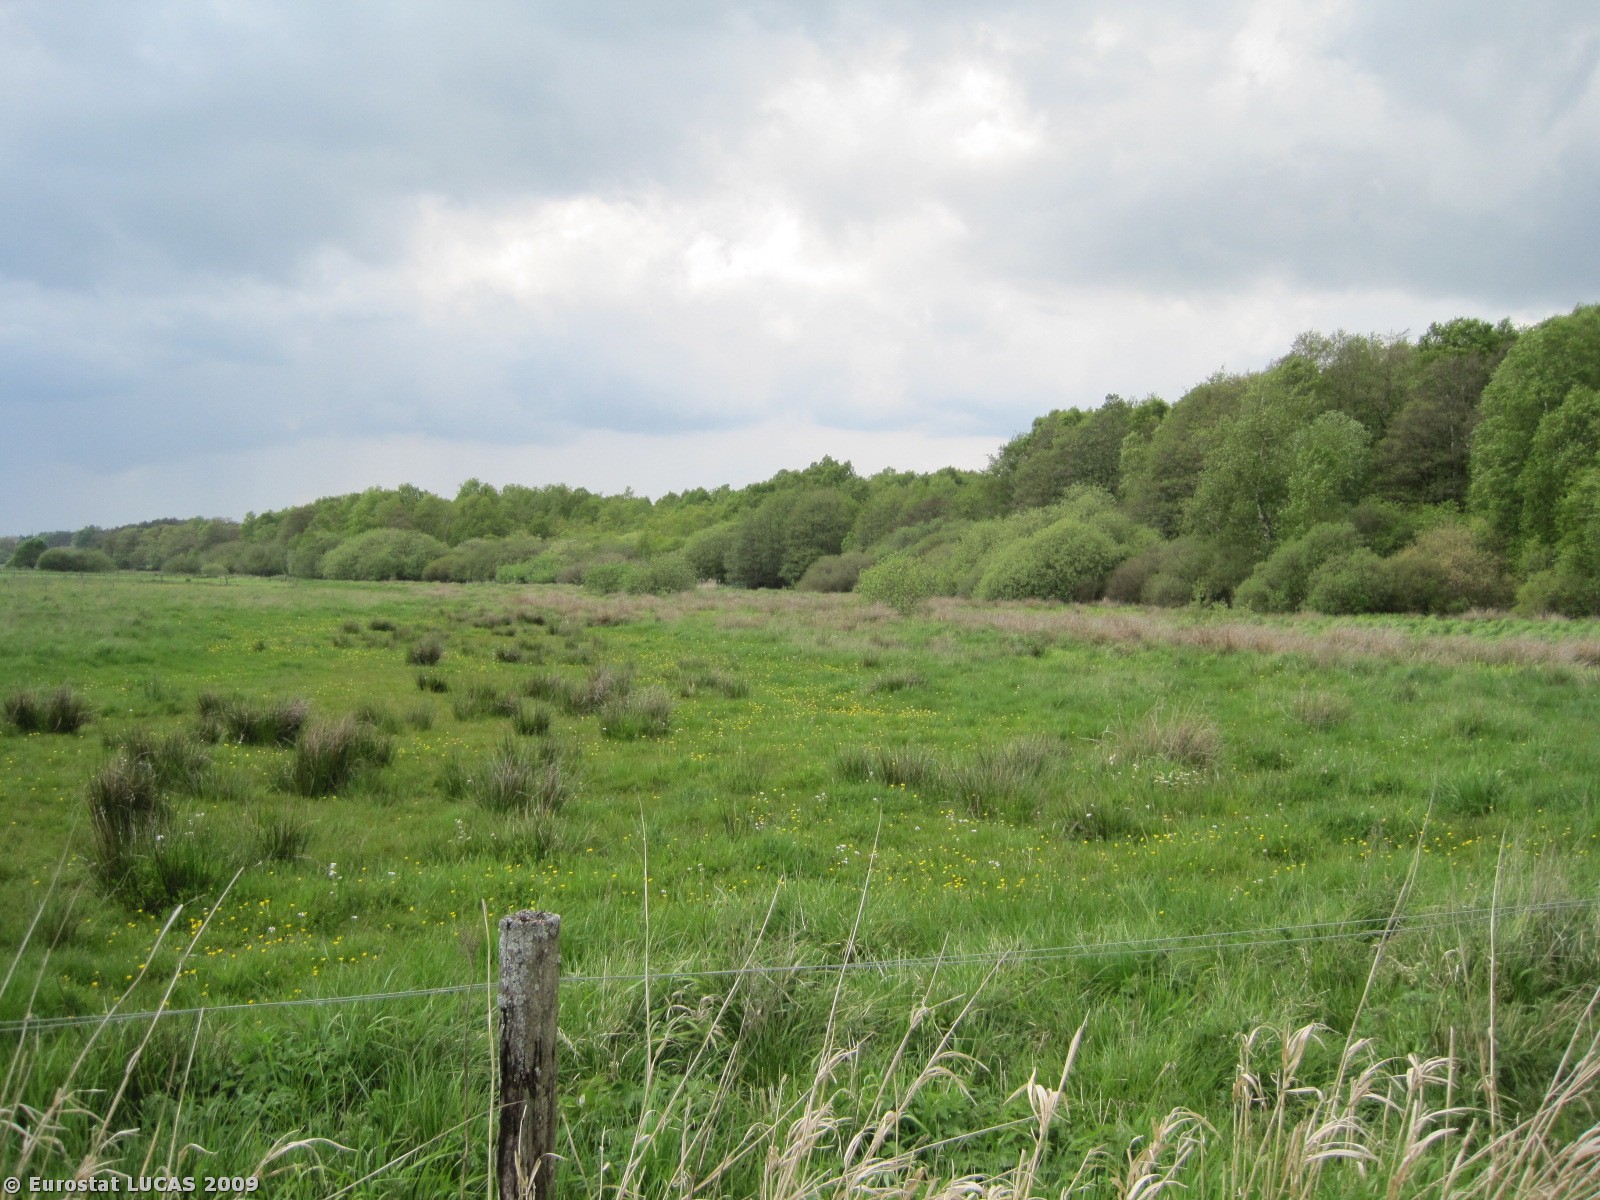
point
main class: Wetlands
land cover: Inland marshes
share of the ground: > 75 %
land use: Unused
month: May
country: DK
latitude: 56.3852
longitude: 9.7250
